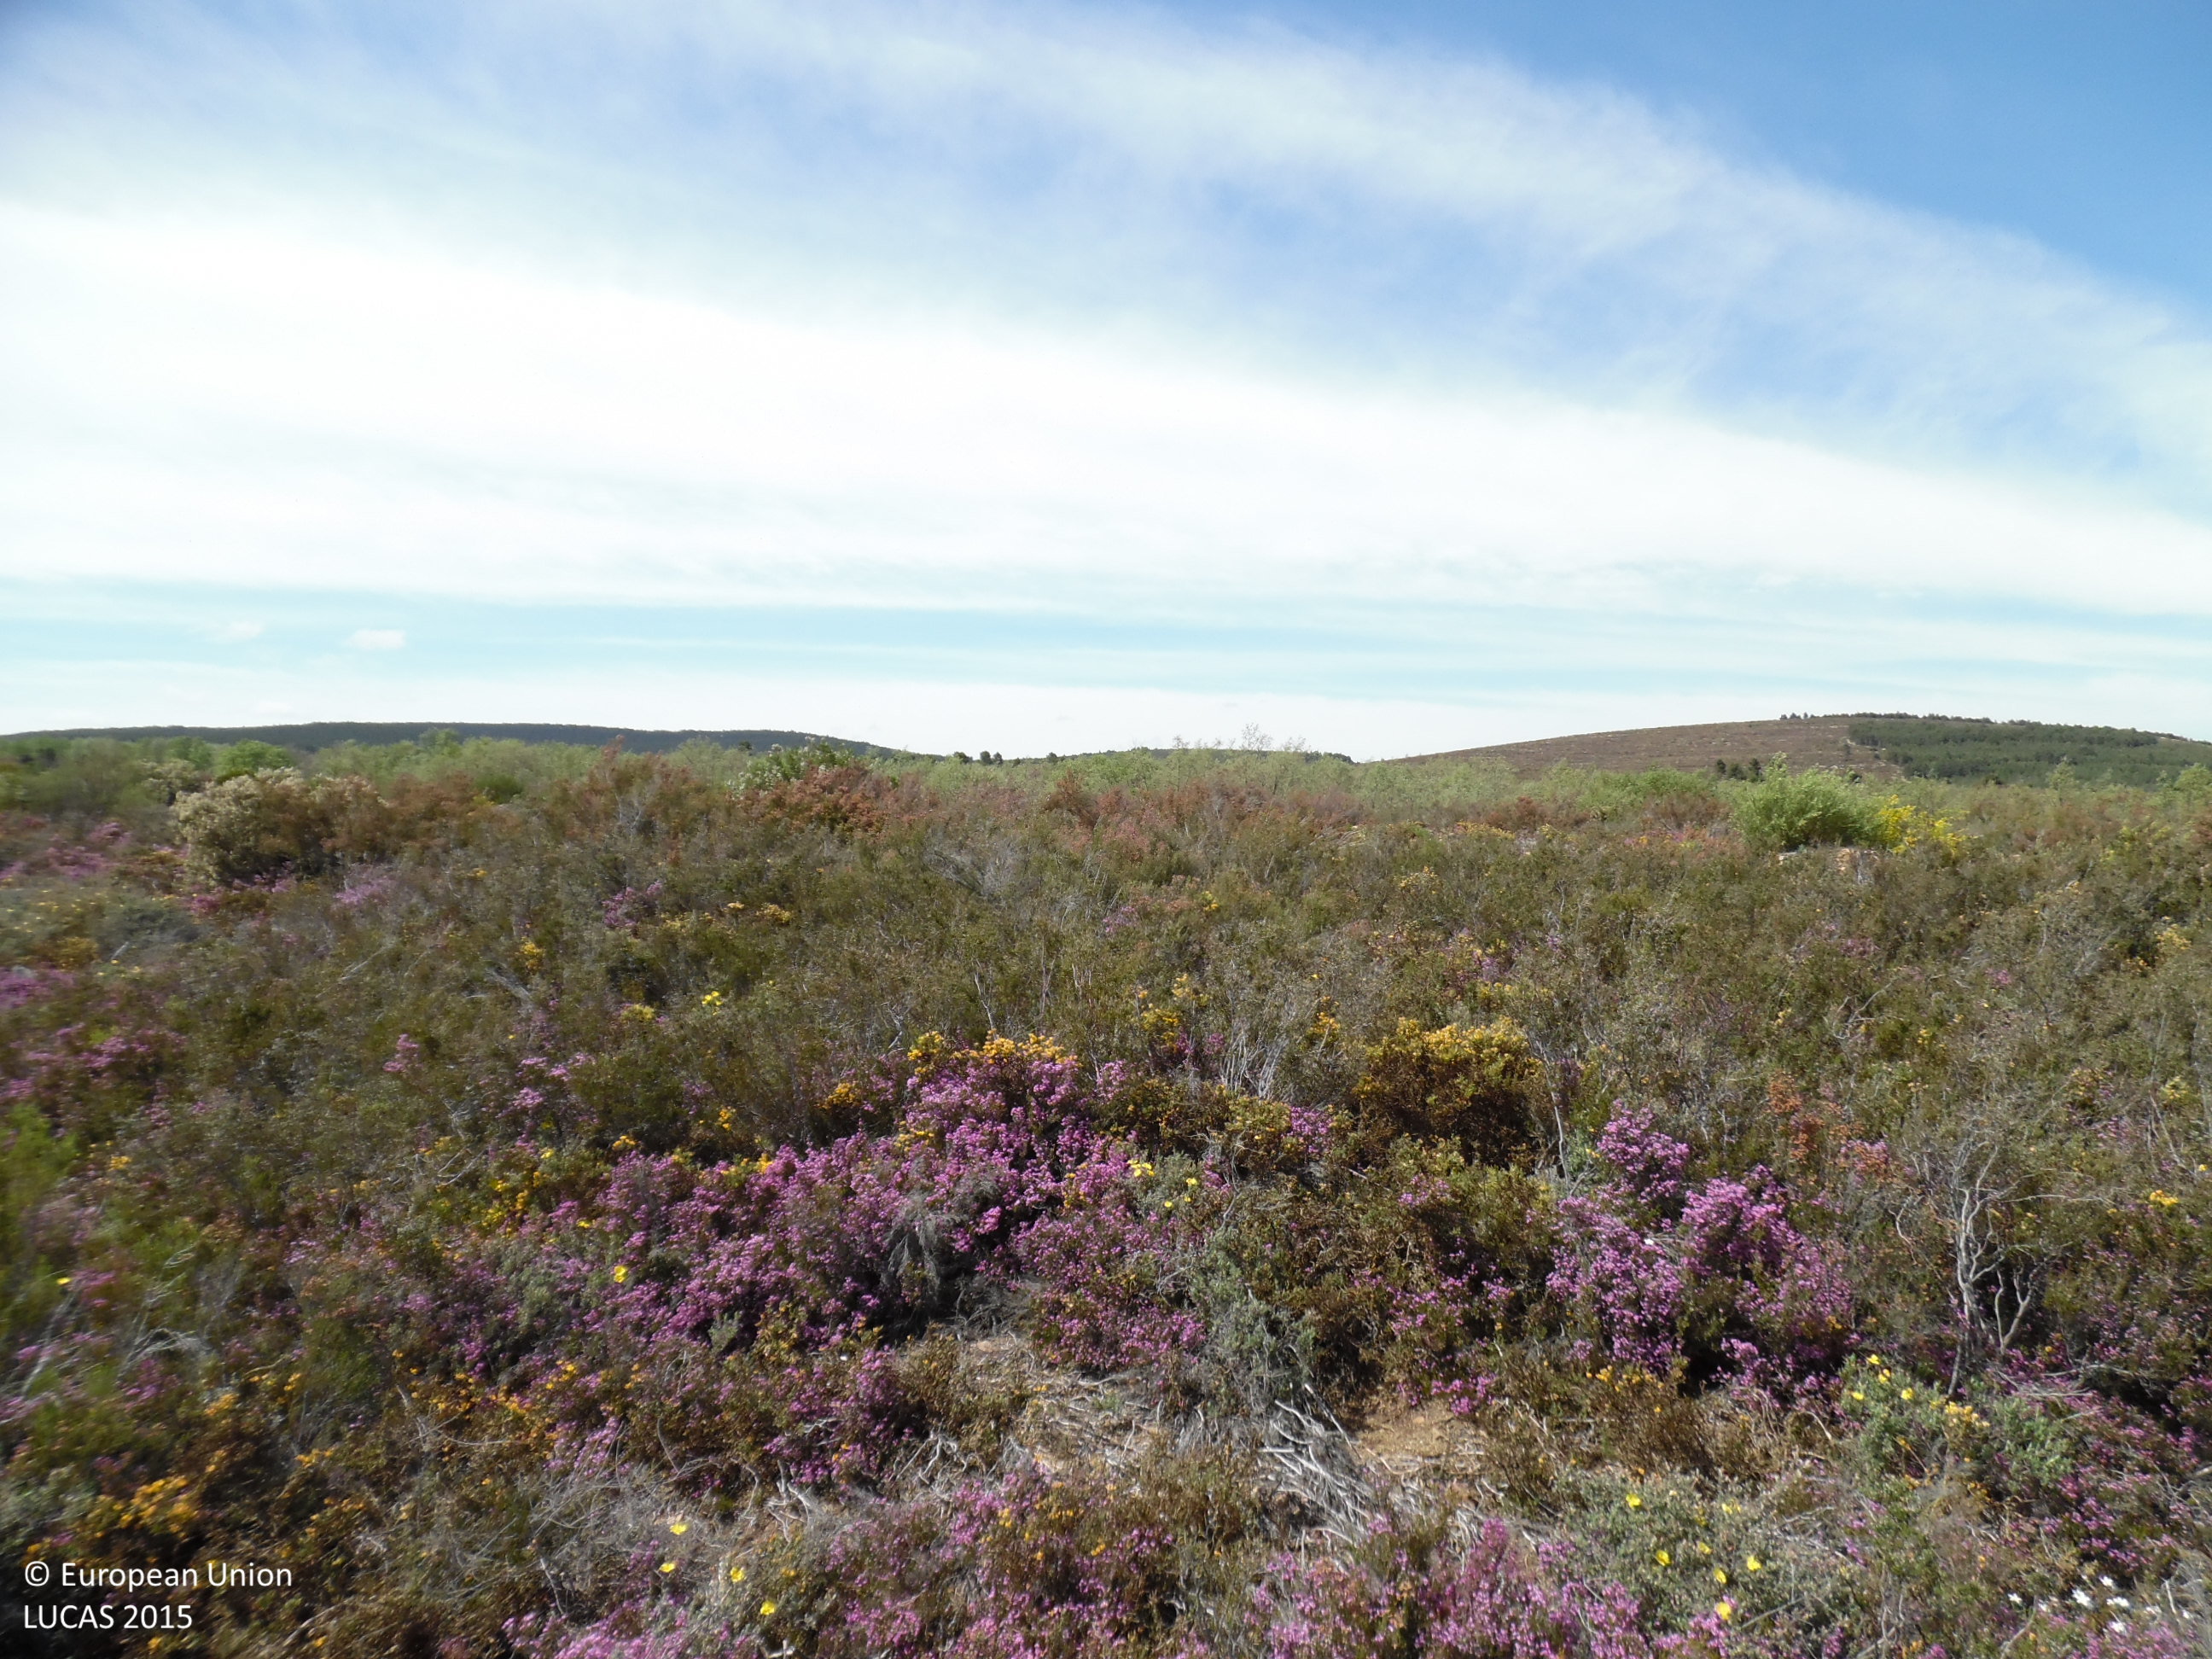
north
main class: Shrubland
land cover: Shrubland without tree cover
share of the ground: > 75 %
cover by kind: shrubs 100 %
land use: Abandoned areas
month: May
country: ES
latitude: 42.5647
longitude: -6.1270
